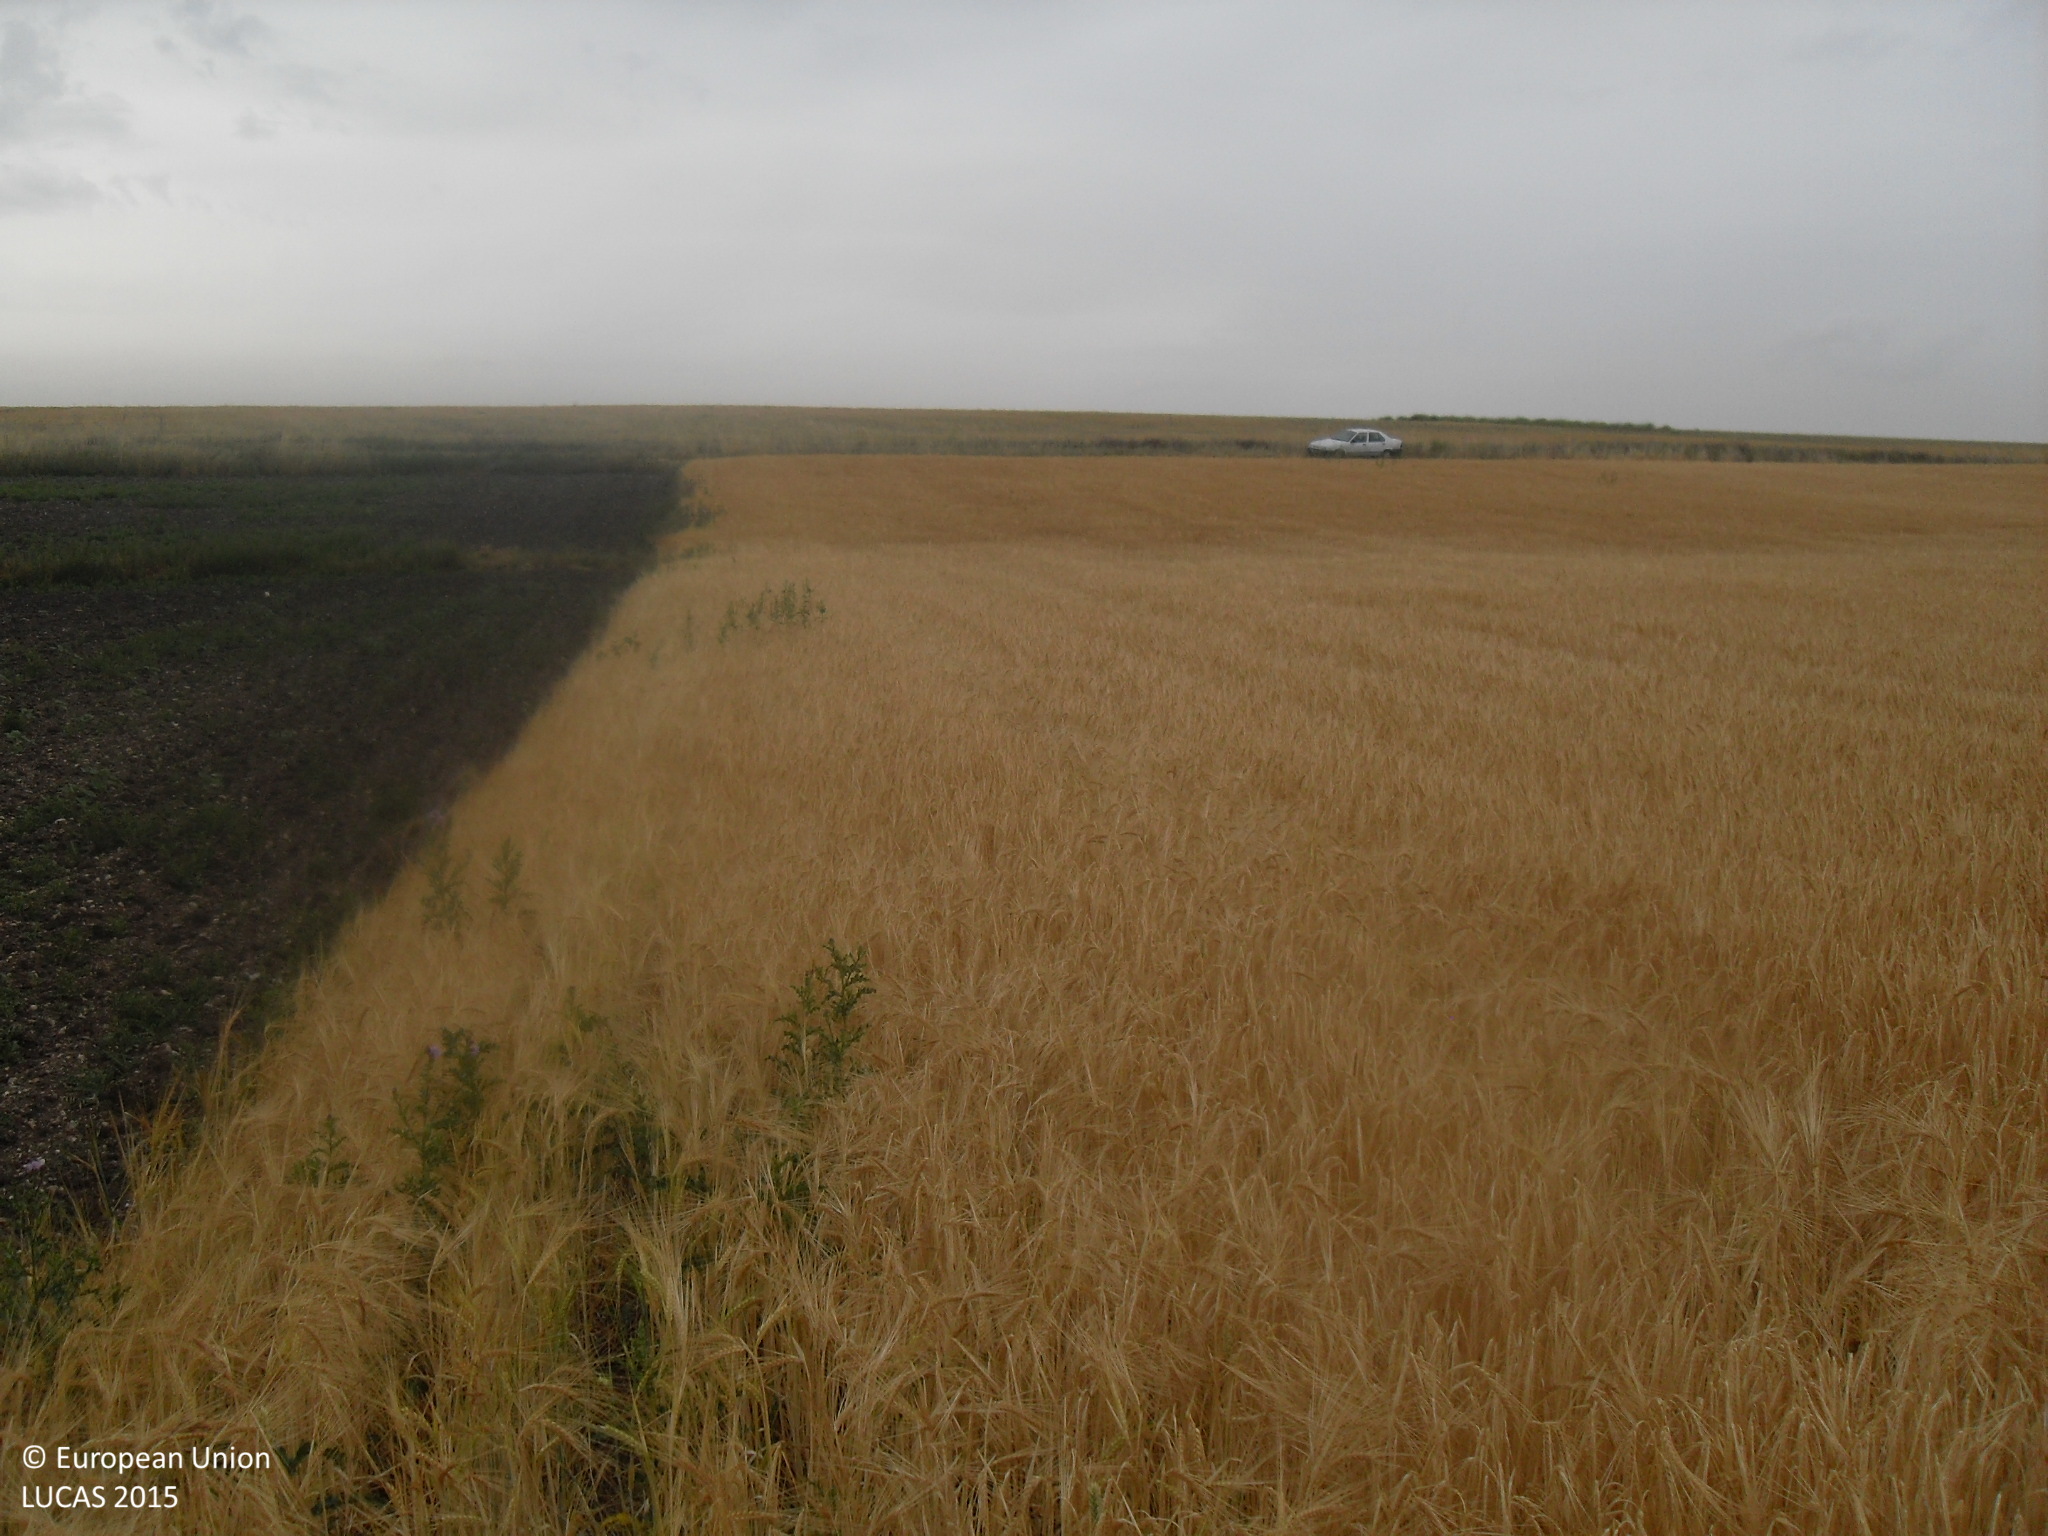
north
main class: Cropland
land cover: Barley
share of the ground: > 75 %
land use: Agriculture (excluding fallow land and kitchen gardens)
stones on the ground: < 10 %
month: June
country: ES
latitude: 41.1061
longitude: -5.7149
